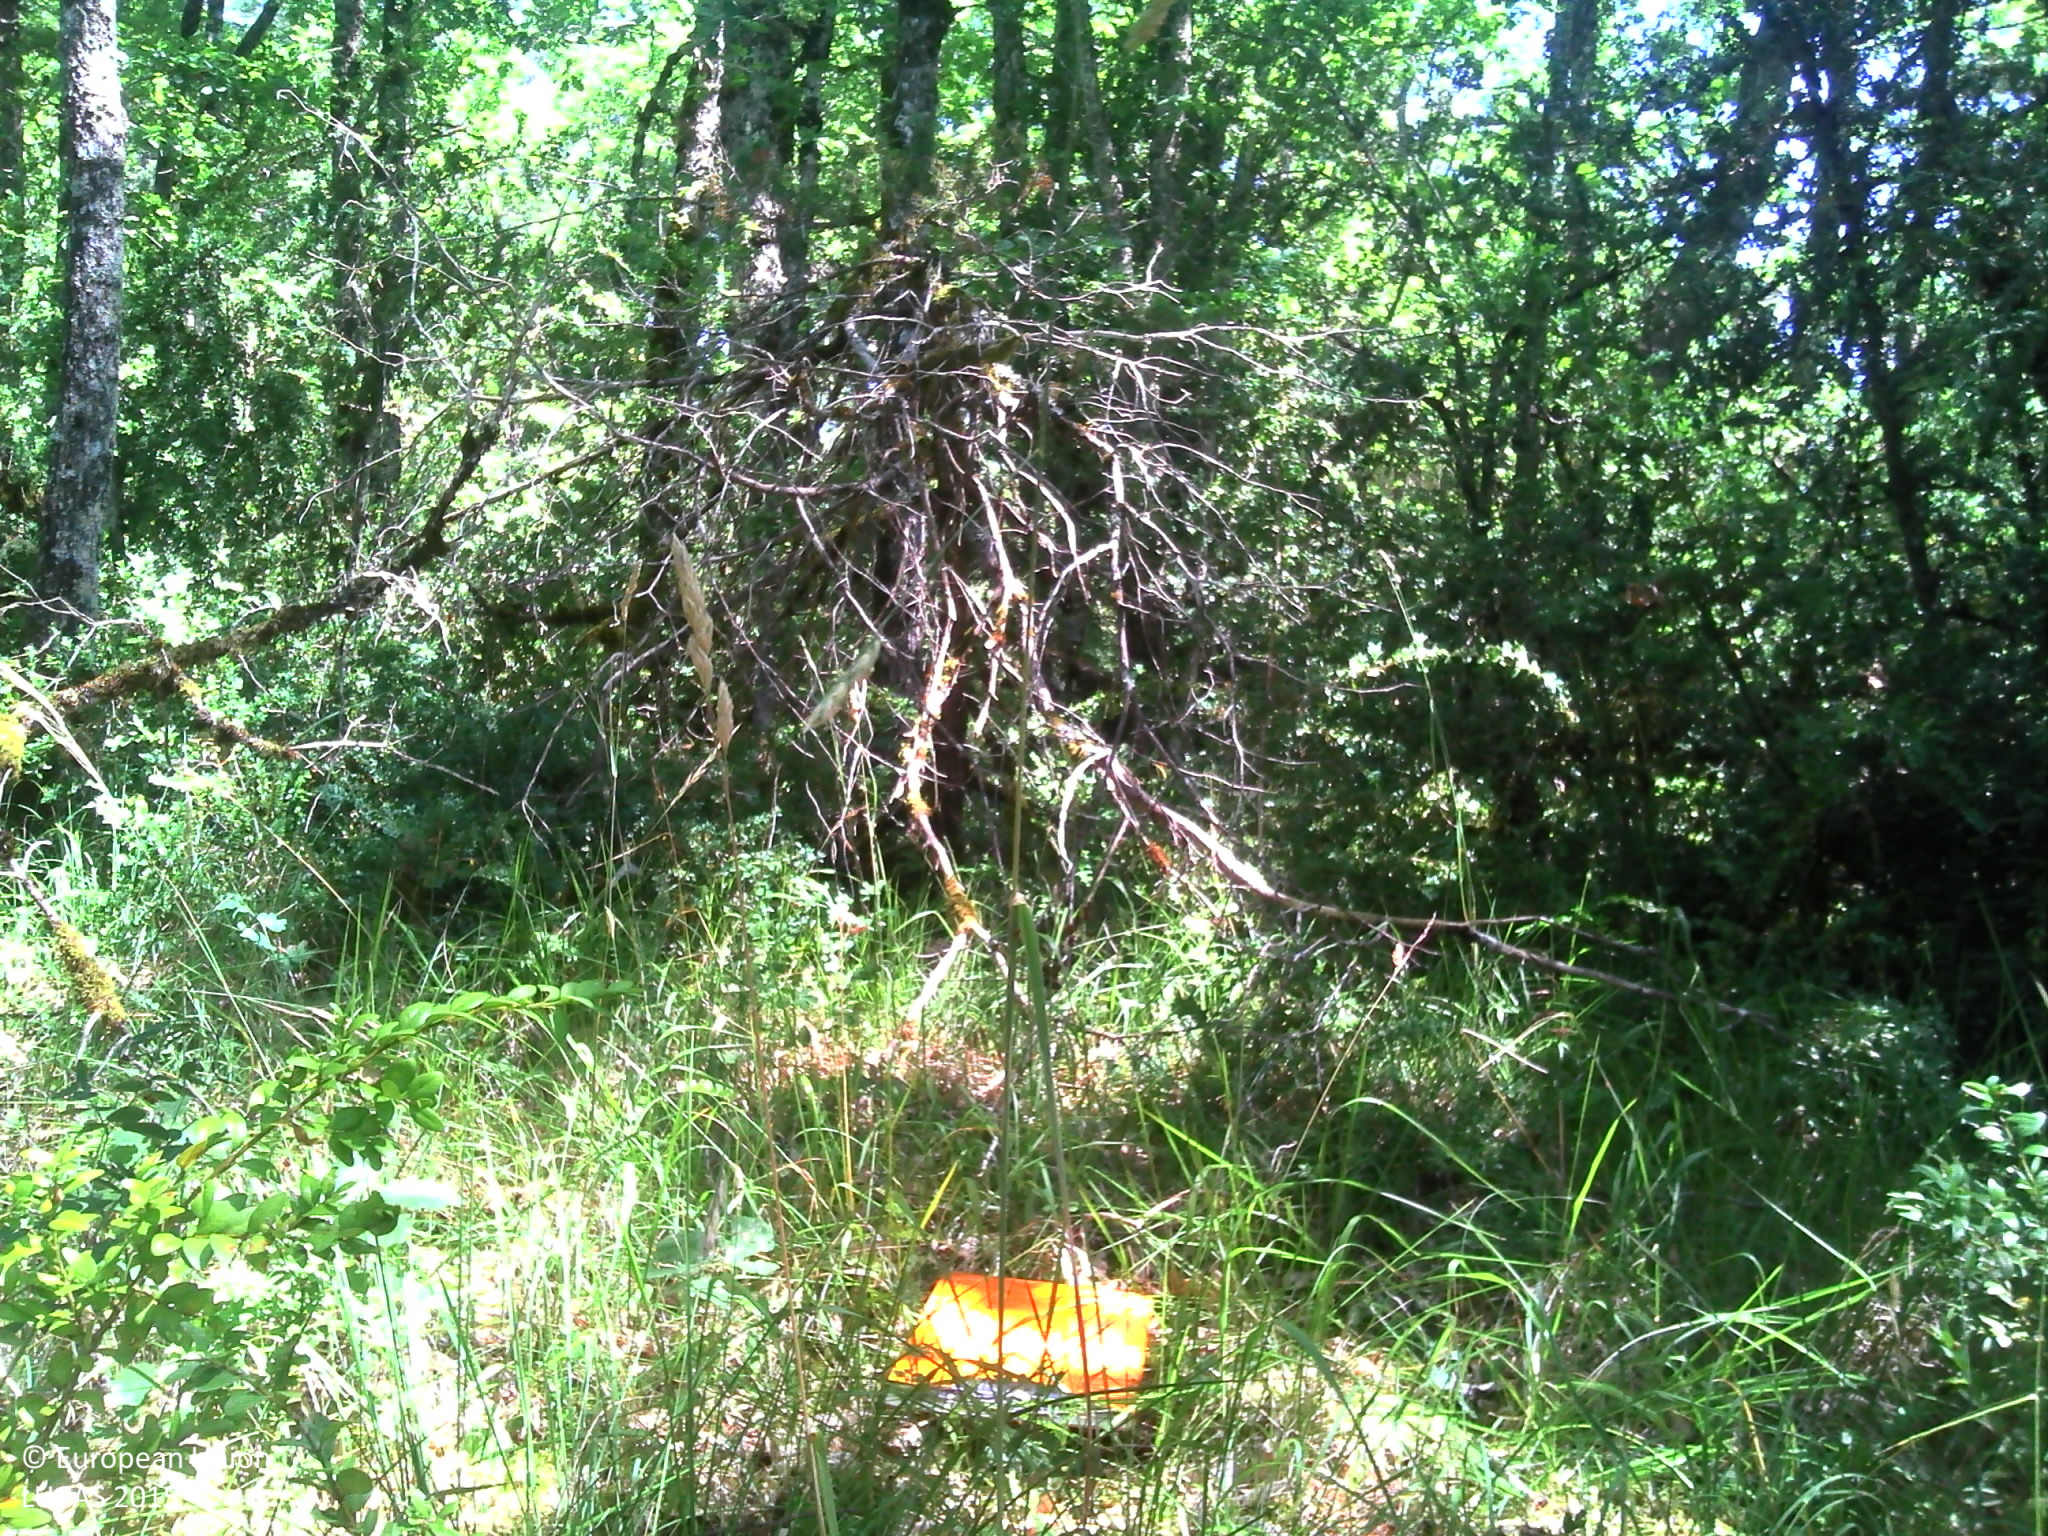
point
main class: Woodland
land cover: Other mixed woodland
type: hemiboreal forest and nemoral coniferous forest and mixed broadleaved-coniferous forest
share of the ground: > 75 %
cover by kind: broadleaved forest trees 75 %, coniferous forest trees 25 %
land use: Forestry
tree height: > 5 m
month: July
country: FR
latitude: 44.3996
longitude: 3.2125
